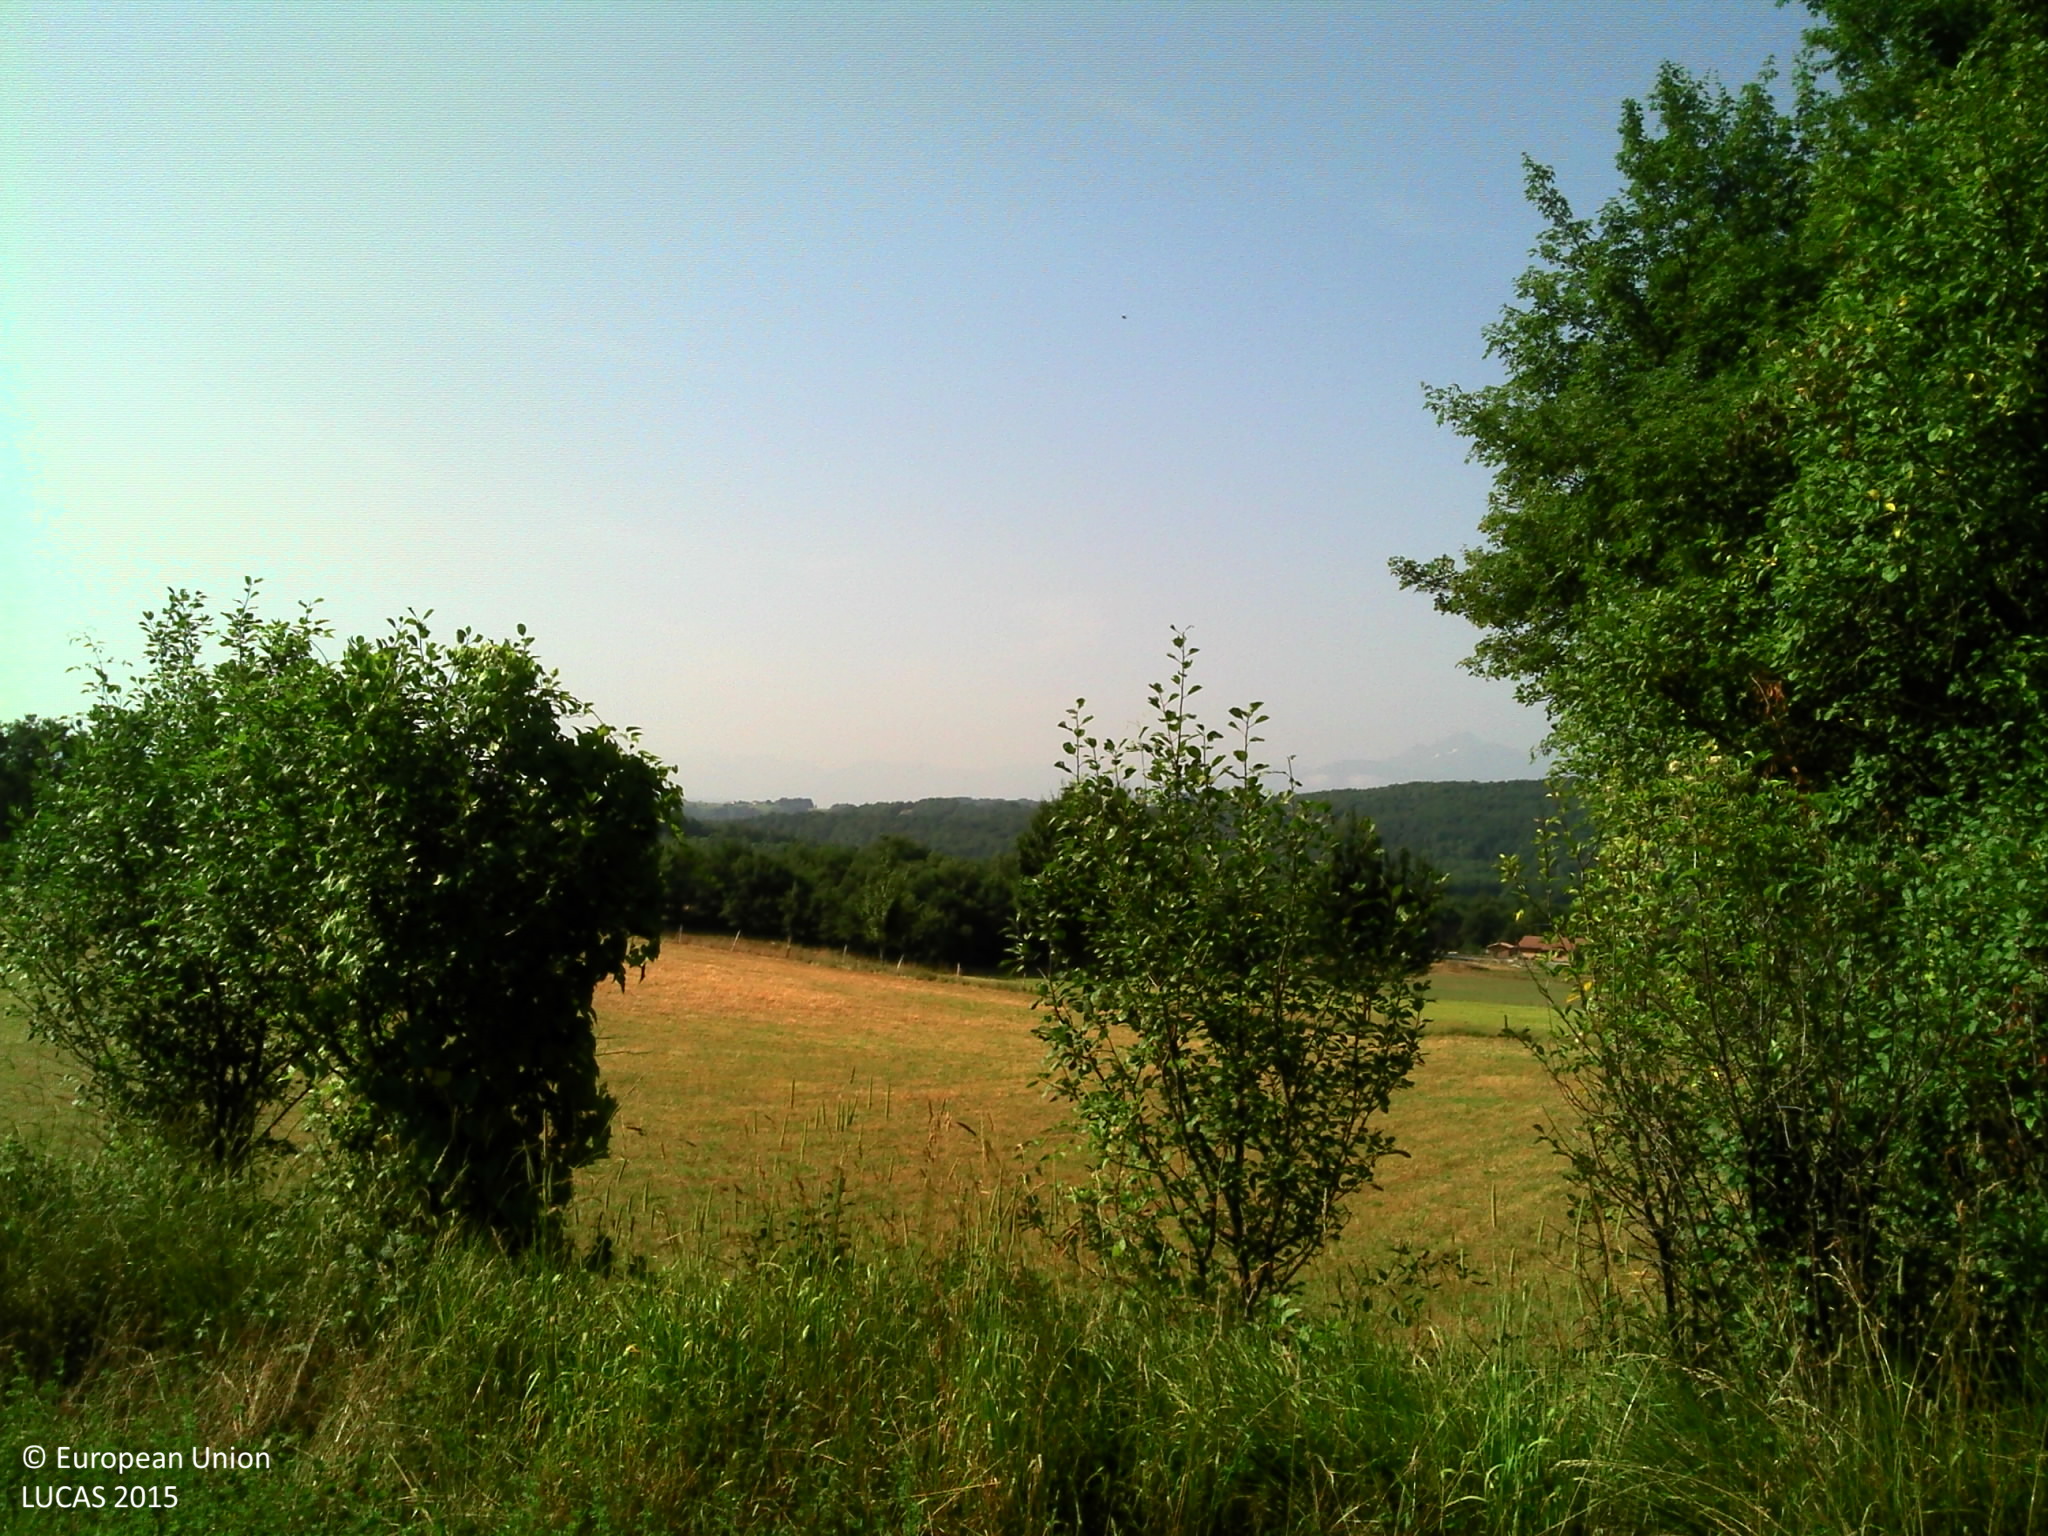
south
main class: Cropland
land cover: Lucerne
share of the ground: > 75 %
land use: Agriculture (excluding fallow land and kitchen gardens)
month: July
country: FR
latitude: 43.1006
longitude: 1.1453
